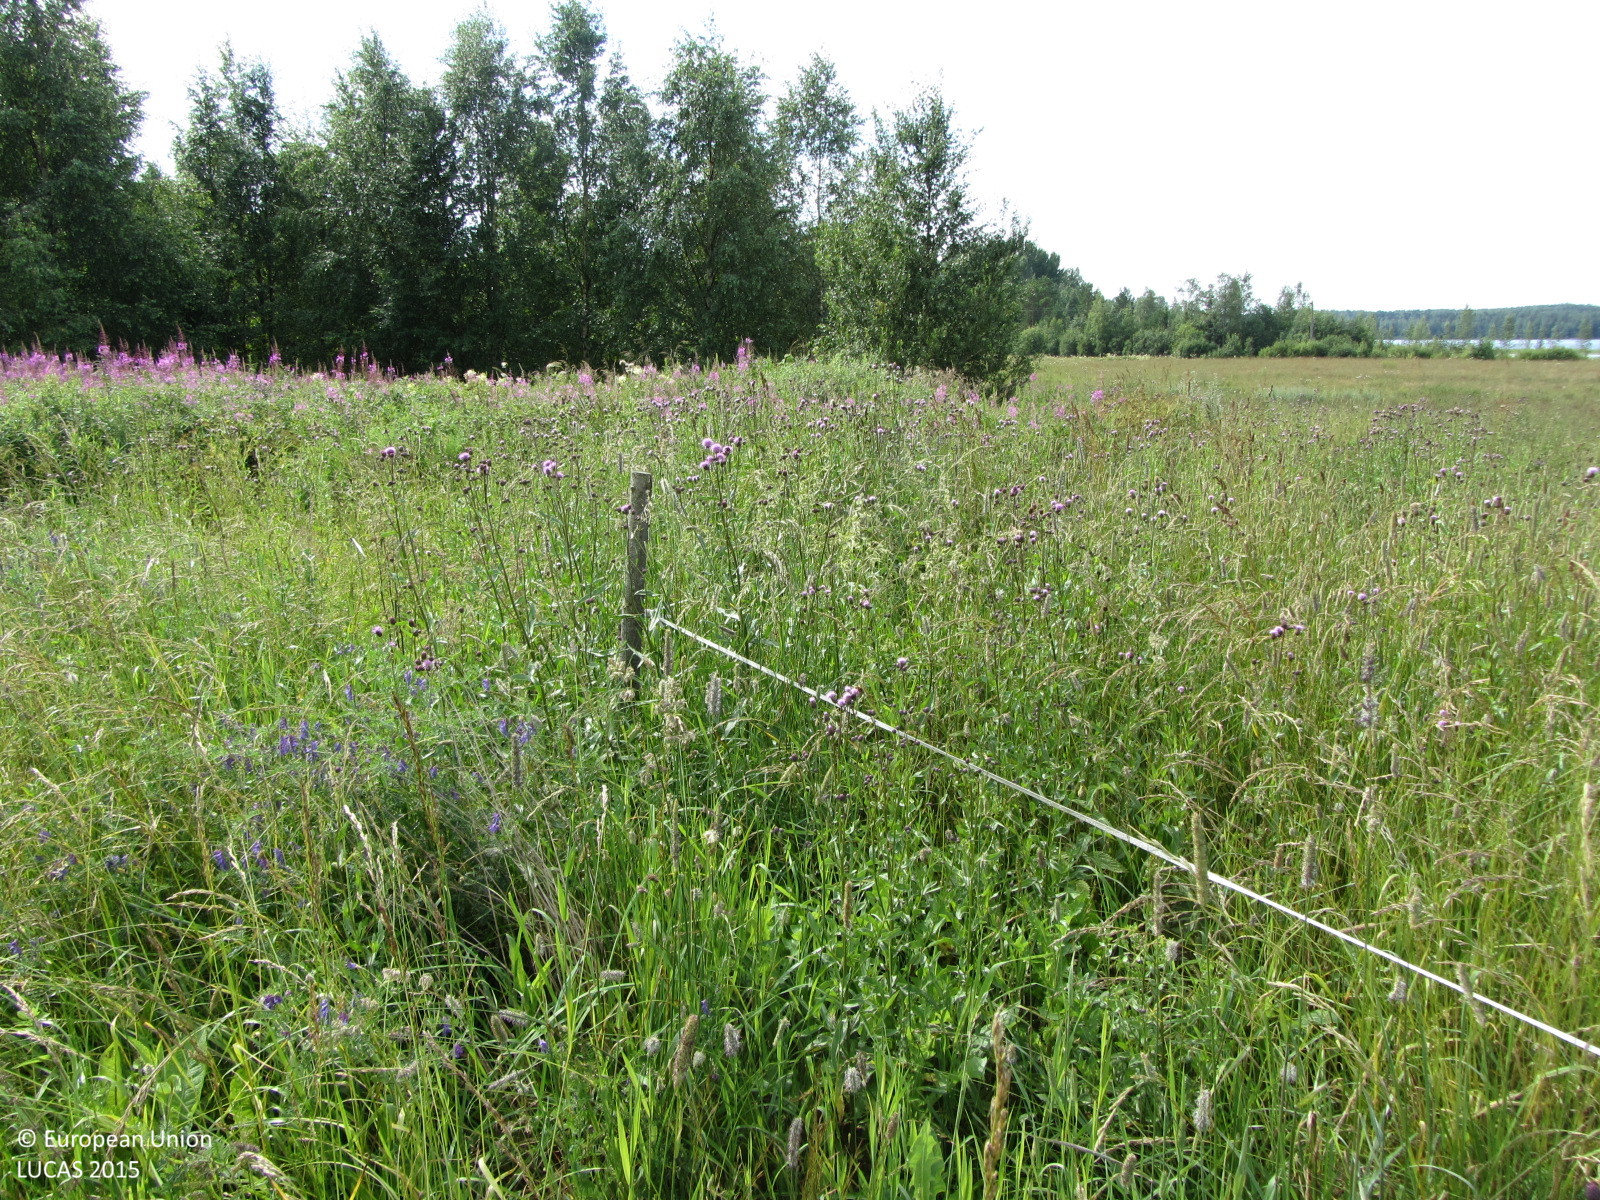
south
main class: Grassland
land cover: Spontaneously vegetated surfaces
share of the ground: > 75 %
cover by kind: herbaceous plants 100 %
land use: Fallow land
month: July
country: FI
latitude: 60.5784
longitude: 24.3557
